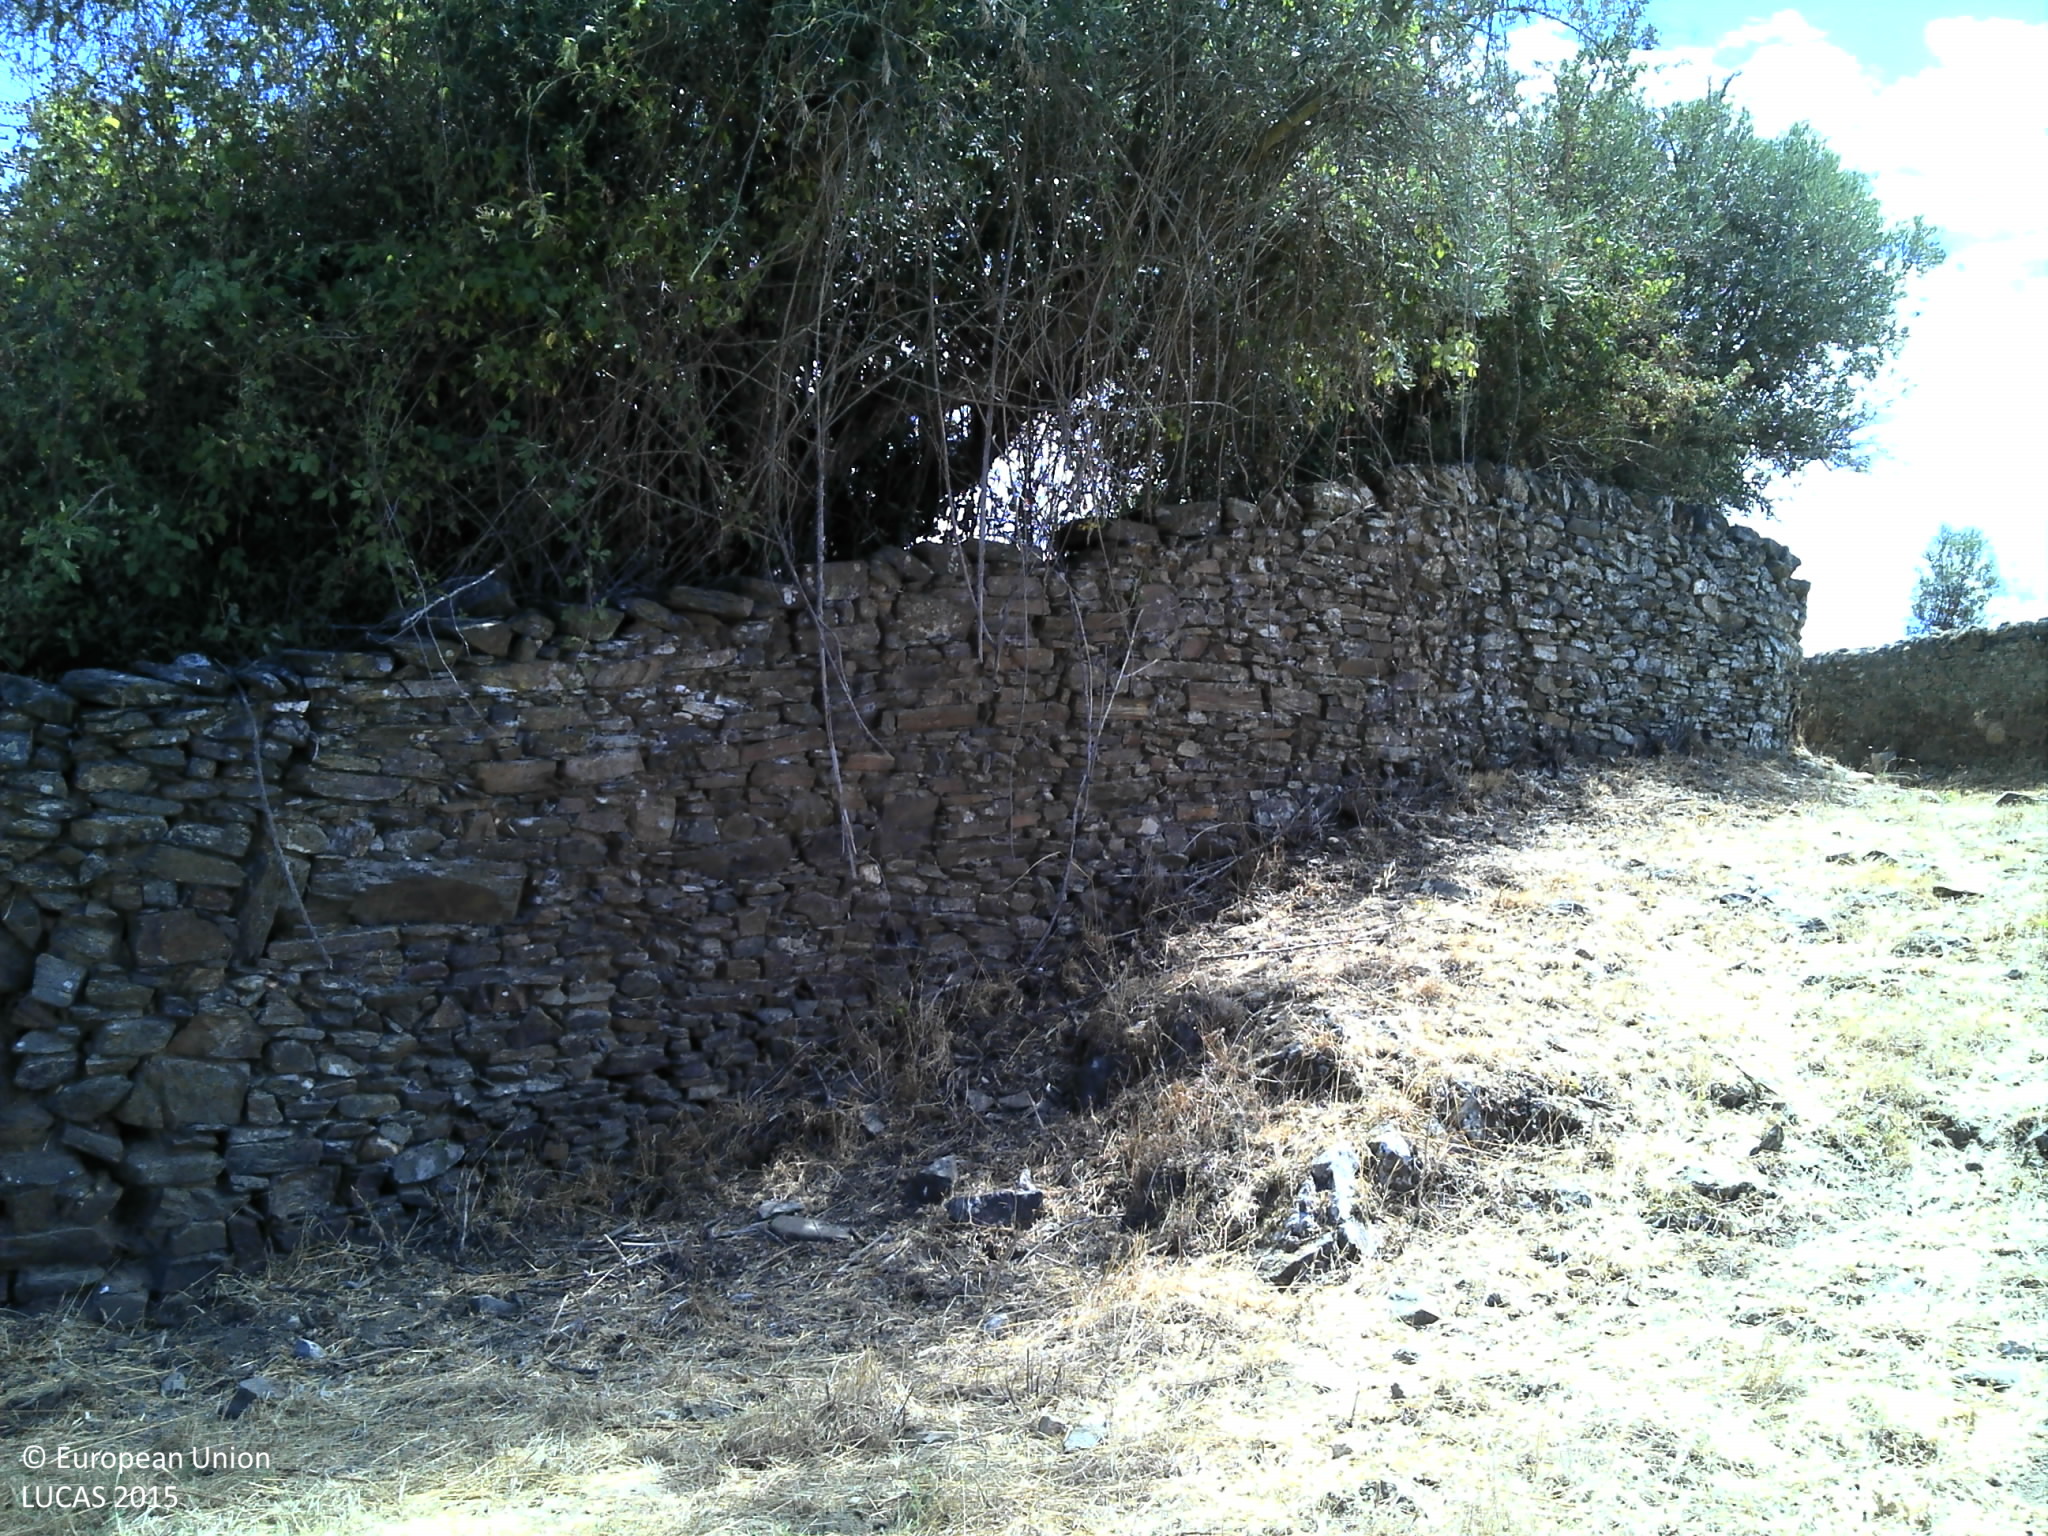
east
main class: Grassland
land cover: Grassland without tree/shrub cover
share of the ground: > 75 %
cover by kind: herbaceous plants 75 %, unconsolidated bare surface 25 %
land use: Agriculture (excluding fallow land and kitchen gardens)
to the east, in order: Grassland without tree/shrub cover; Dry stone walls; Olive groves; Grassland without tree/shrub cover
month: August
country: PT
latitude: 39.5249
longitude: -7.6279
